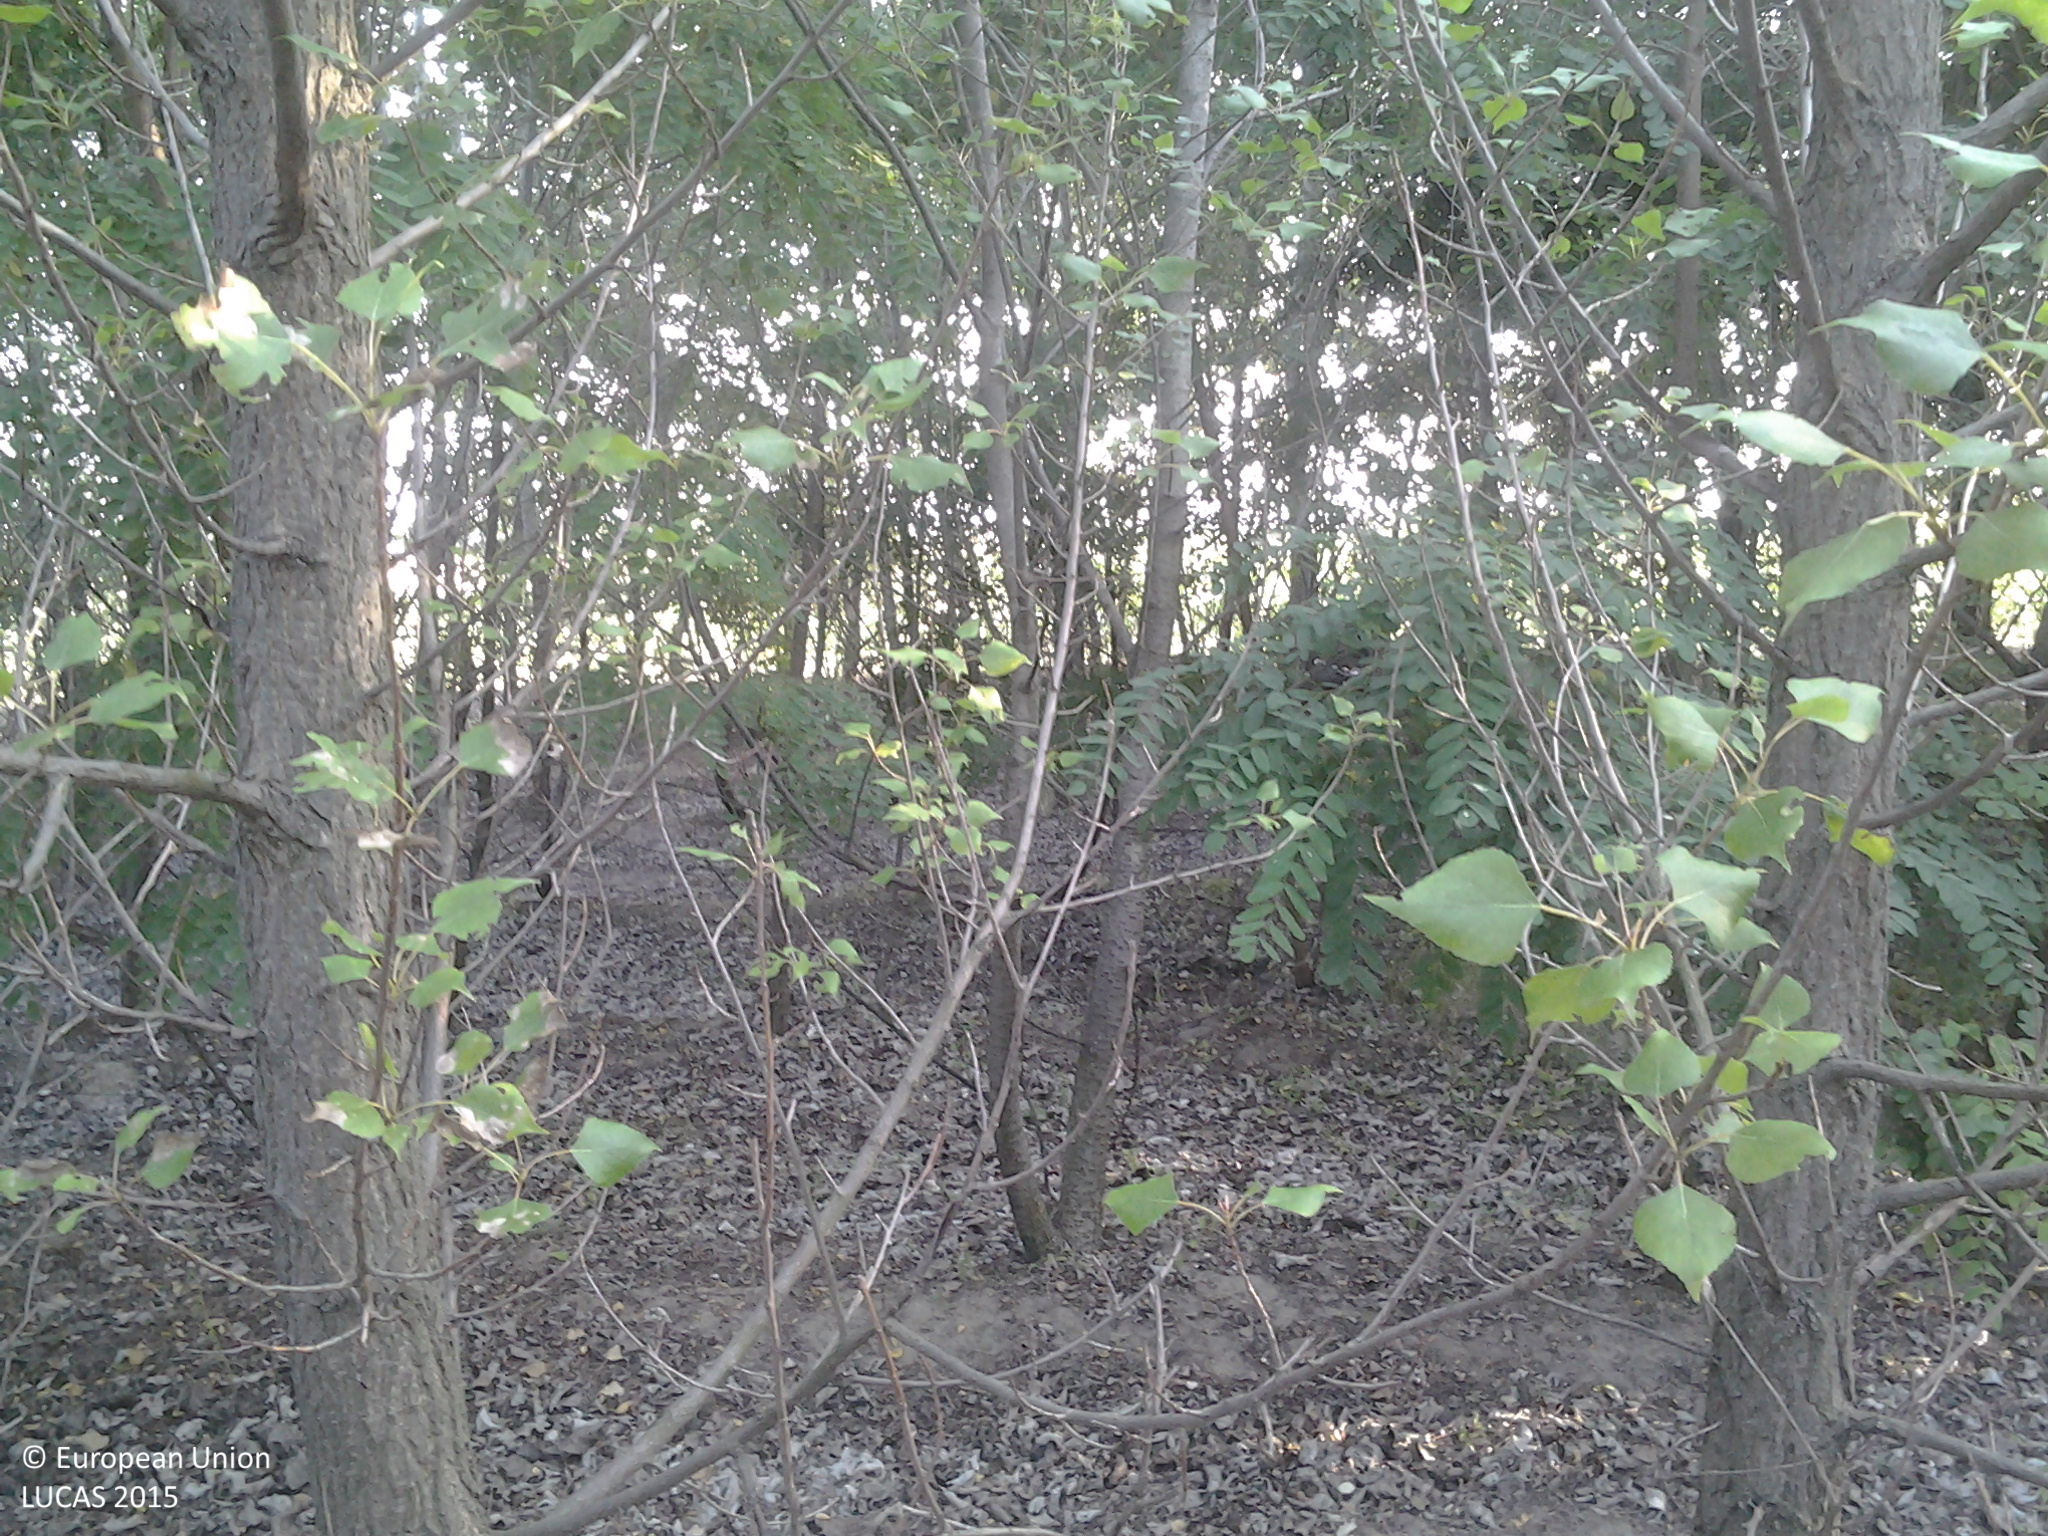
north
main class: Woodland
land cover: Broadleaved woodland
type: mesophytic deciduous forest
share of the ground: 50 - 75 %
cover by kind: broadleaved forest trees 100 %
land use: Forestry
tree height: > 5 m
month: July
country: HU
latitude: 46.9639
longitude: 19.2564
